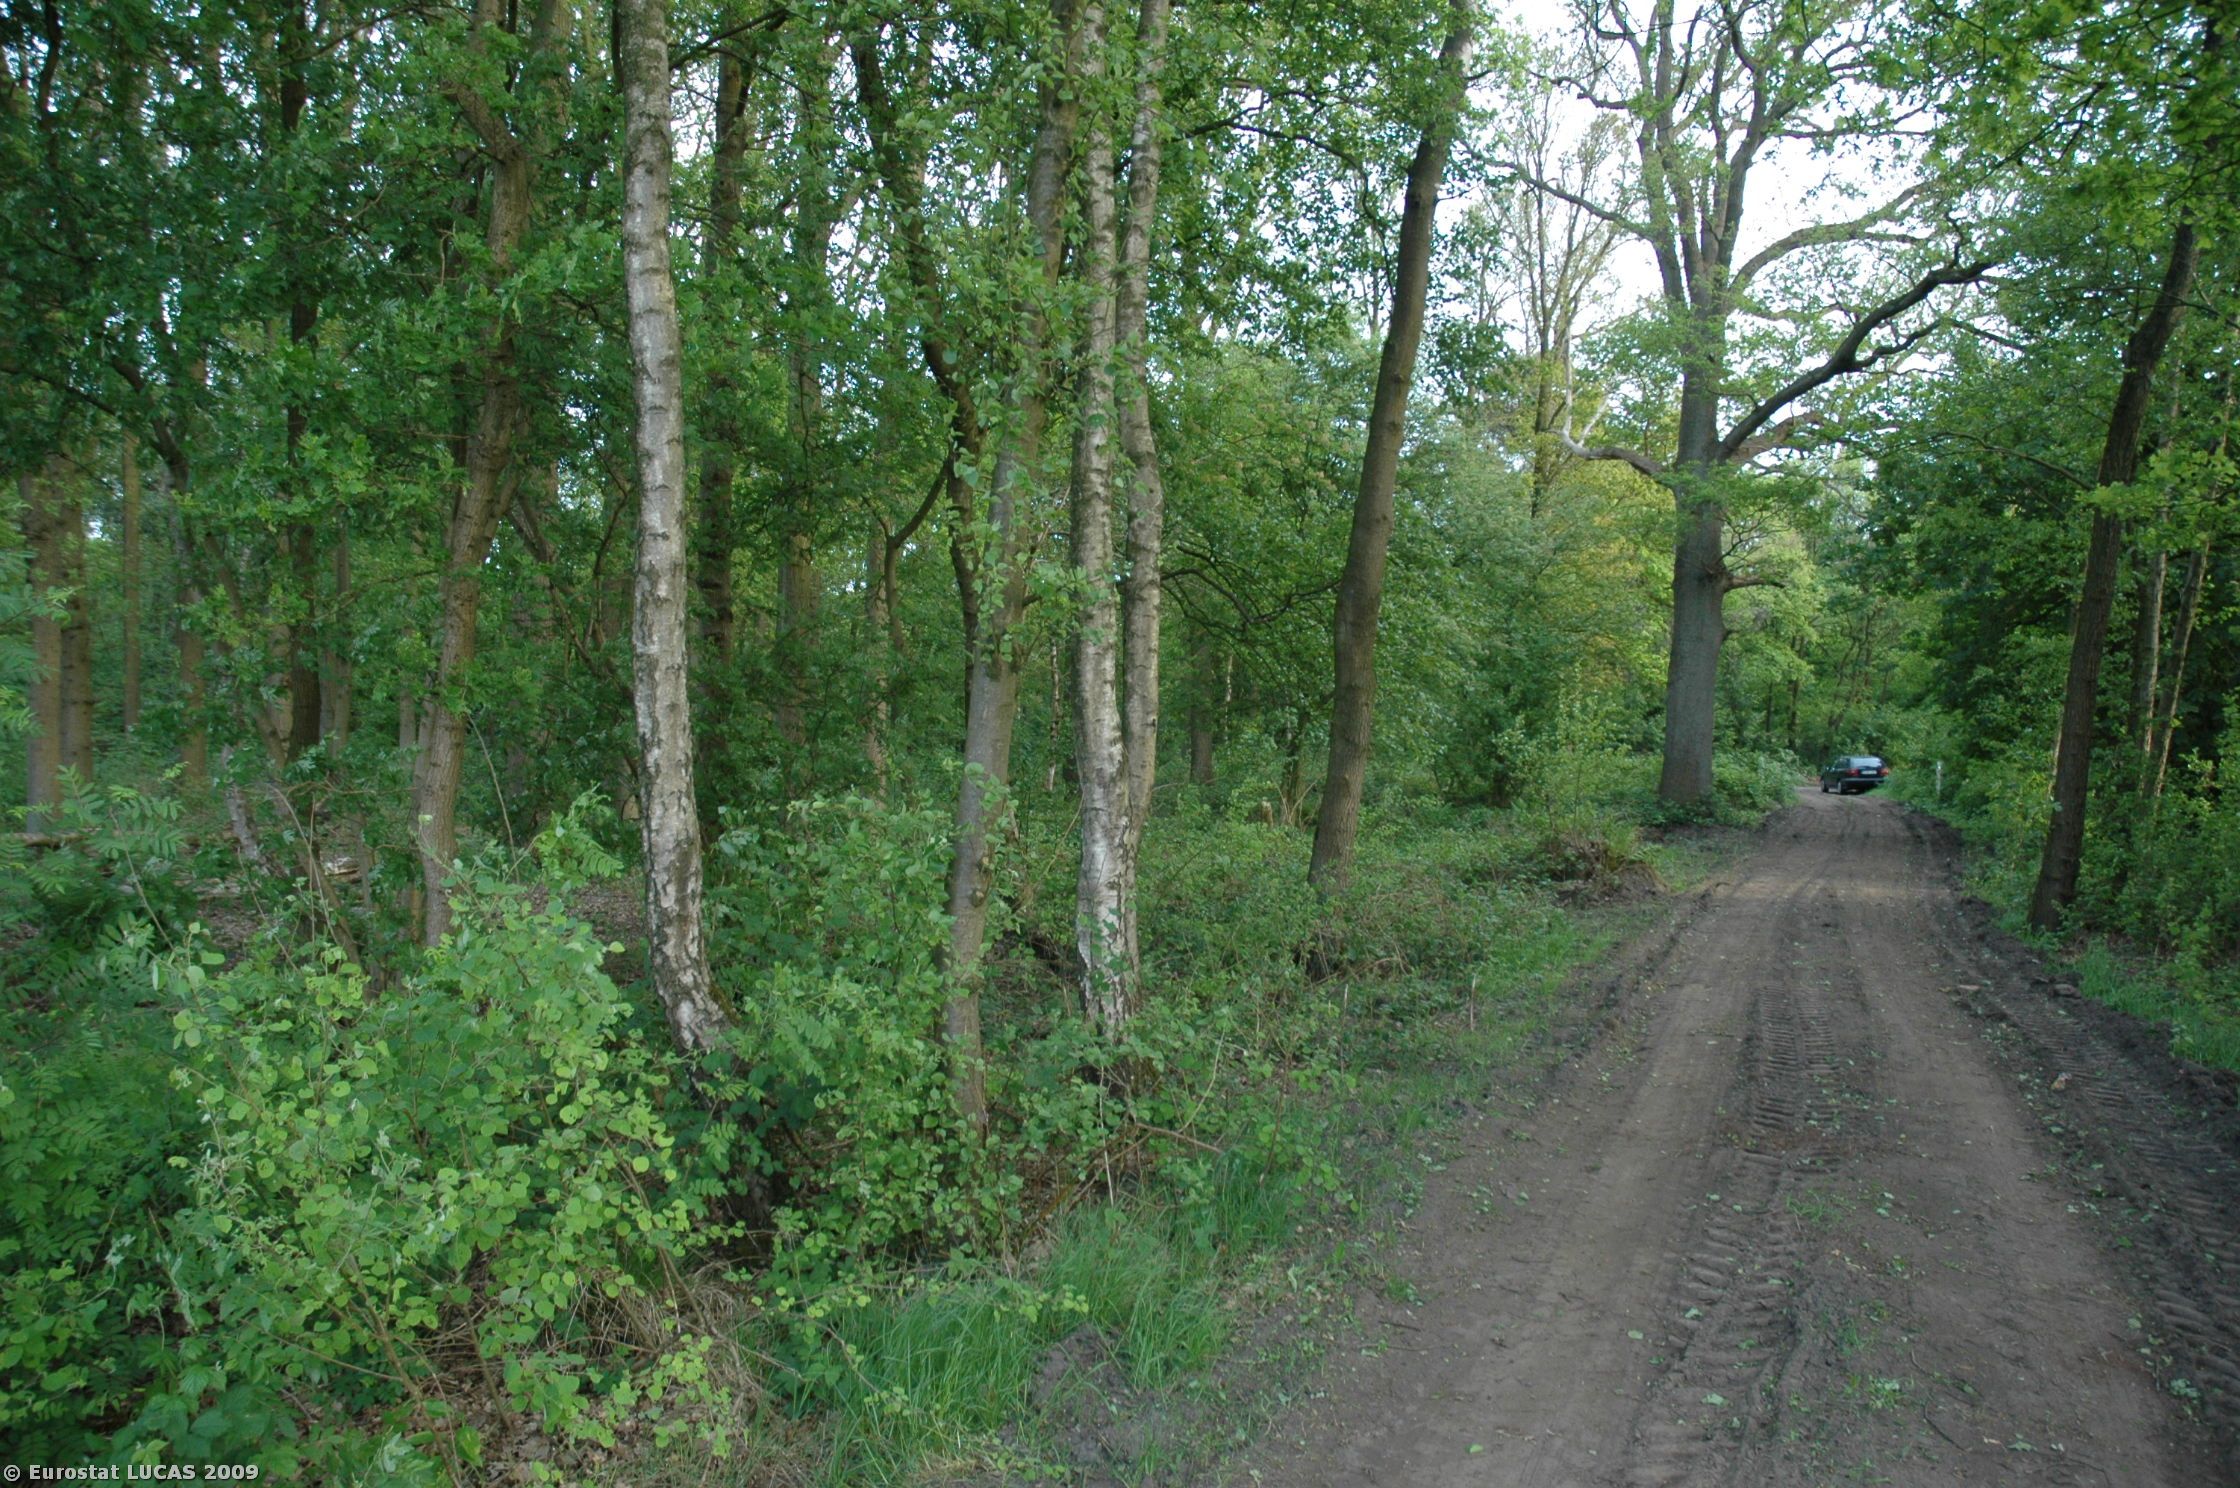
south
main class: Grassland
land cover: Grassland without tree/shrub cover
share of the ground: > 75 %
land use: Agriculture (excluding fallow land and kitchen gardens)
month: May
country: NL
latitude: 52.0556
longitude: 5.4334
